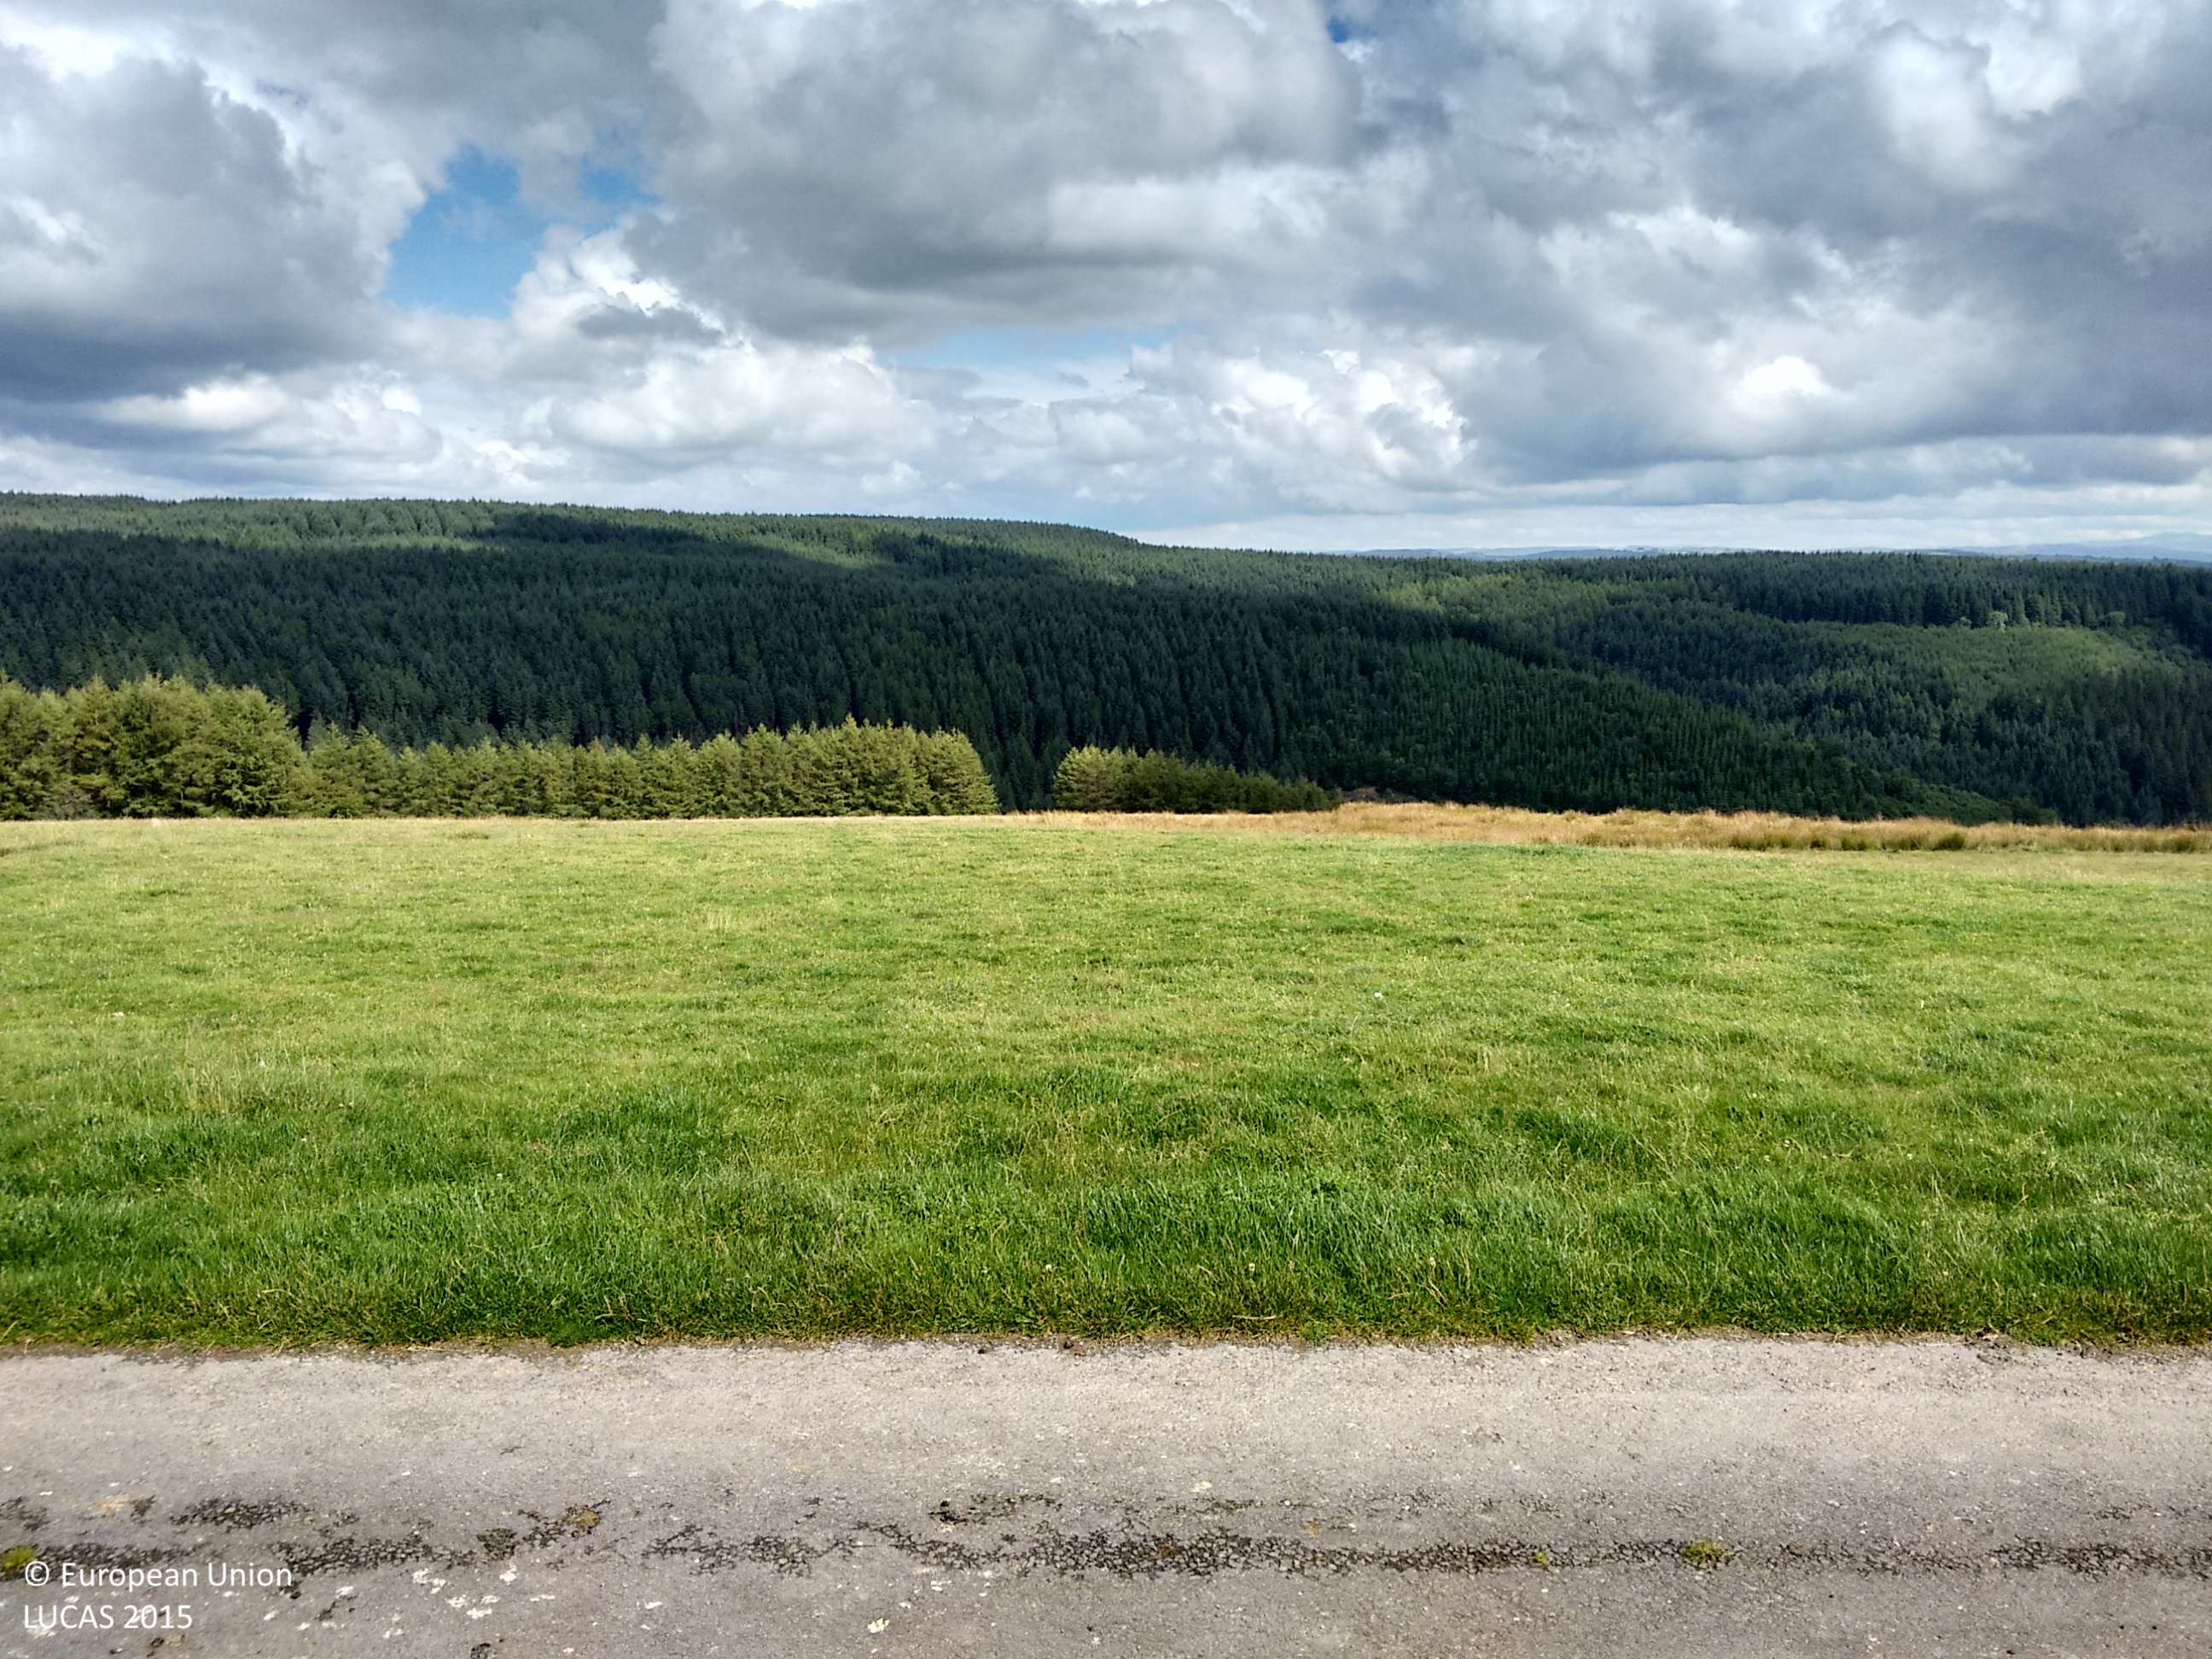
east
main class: Grassland
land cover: Grassland without tree/shrub cover
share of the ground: > 75 %
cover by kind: herbaceous plants 100 %
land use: Agriculture (excluding fallow land and kitchen gardens)
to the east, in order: Grassland without tree/shrub cover; Fences; Grass margins; Paved roads, cycling and walking lanes; Grassland without tree/shrub cover
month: August
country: GB
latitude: 52.0055
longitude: -4.0961
